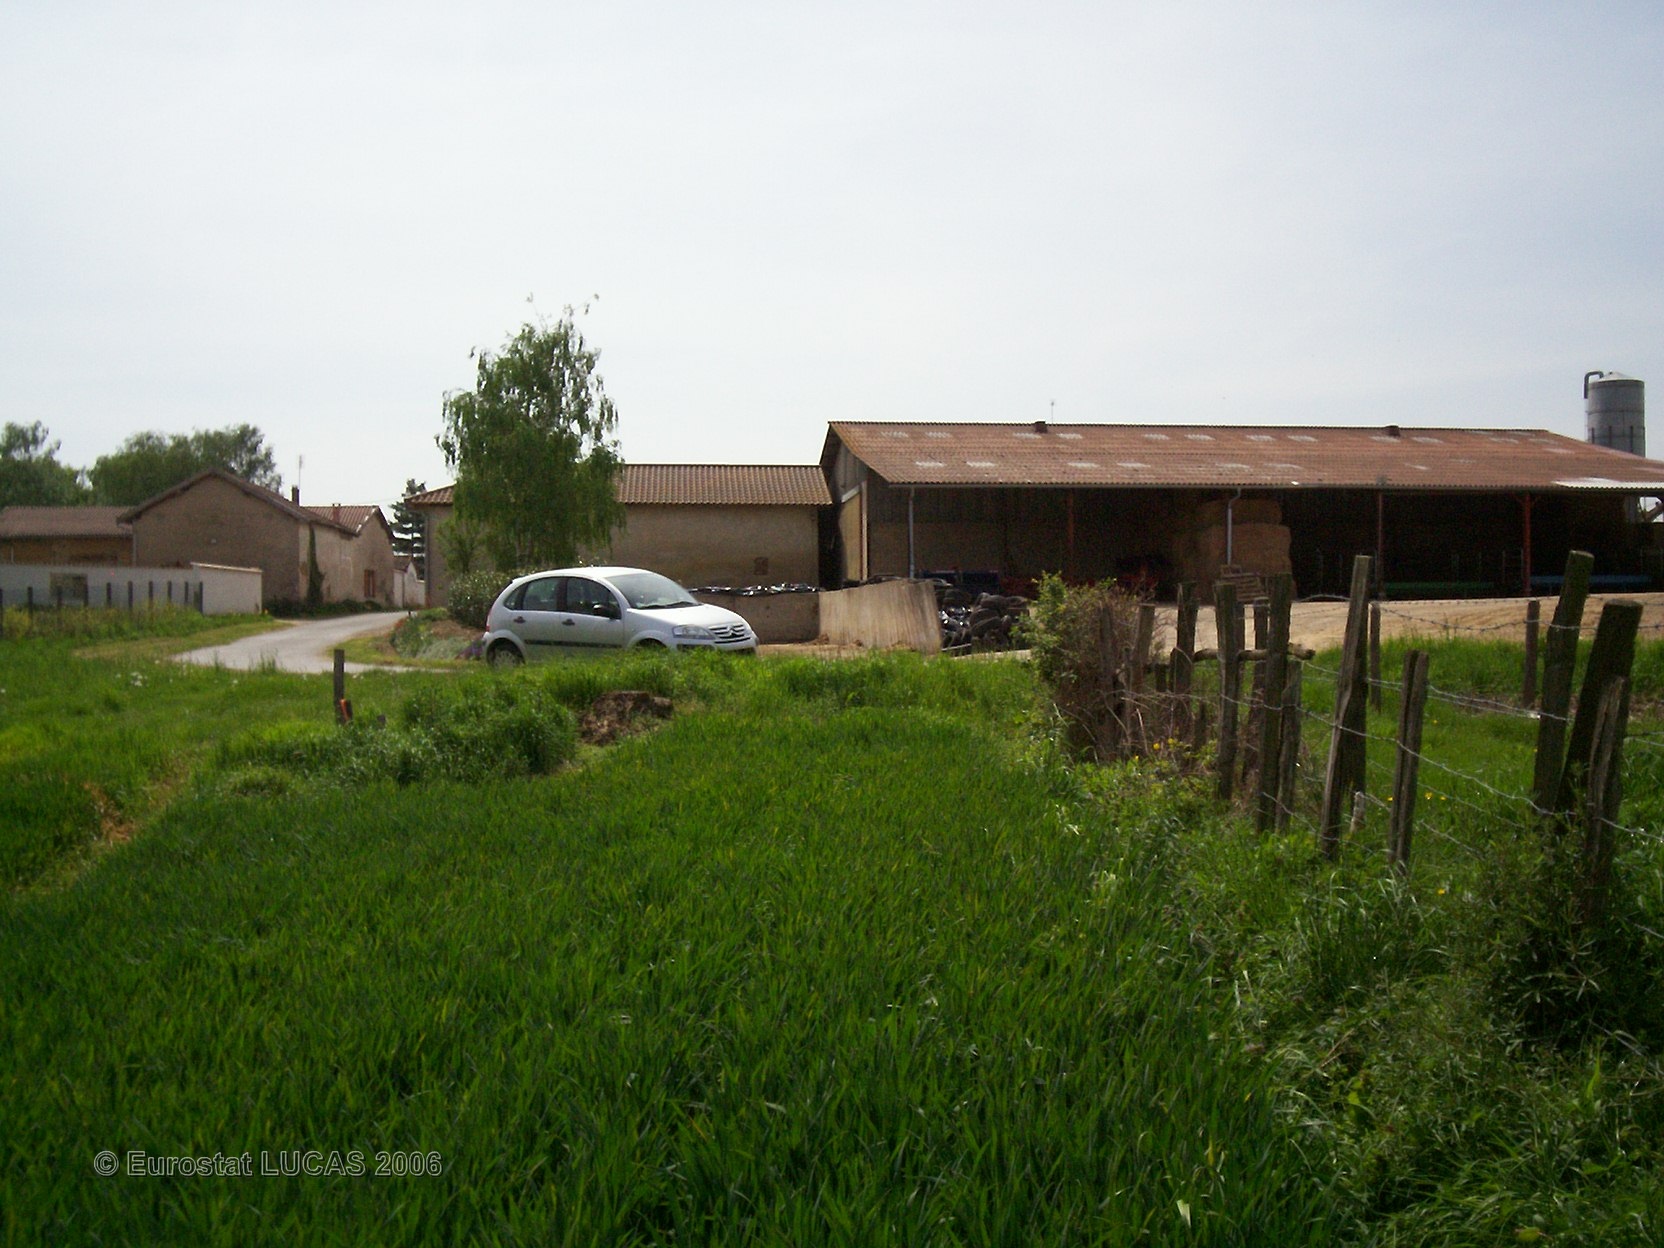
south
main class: Cropland
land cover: Common wheat
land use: Agriculture (excluding fallow land and kitchen gardens)
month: May
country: FR
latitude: 46.1915
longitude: 4.8586
